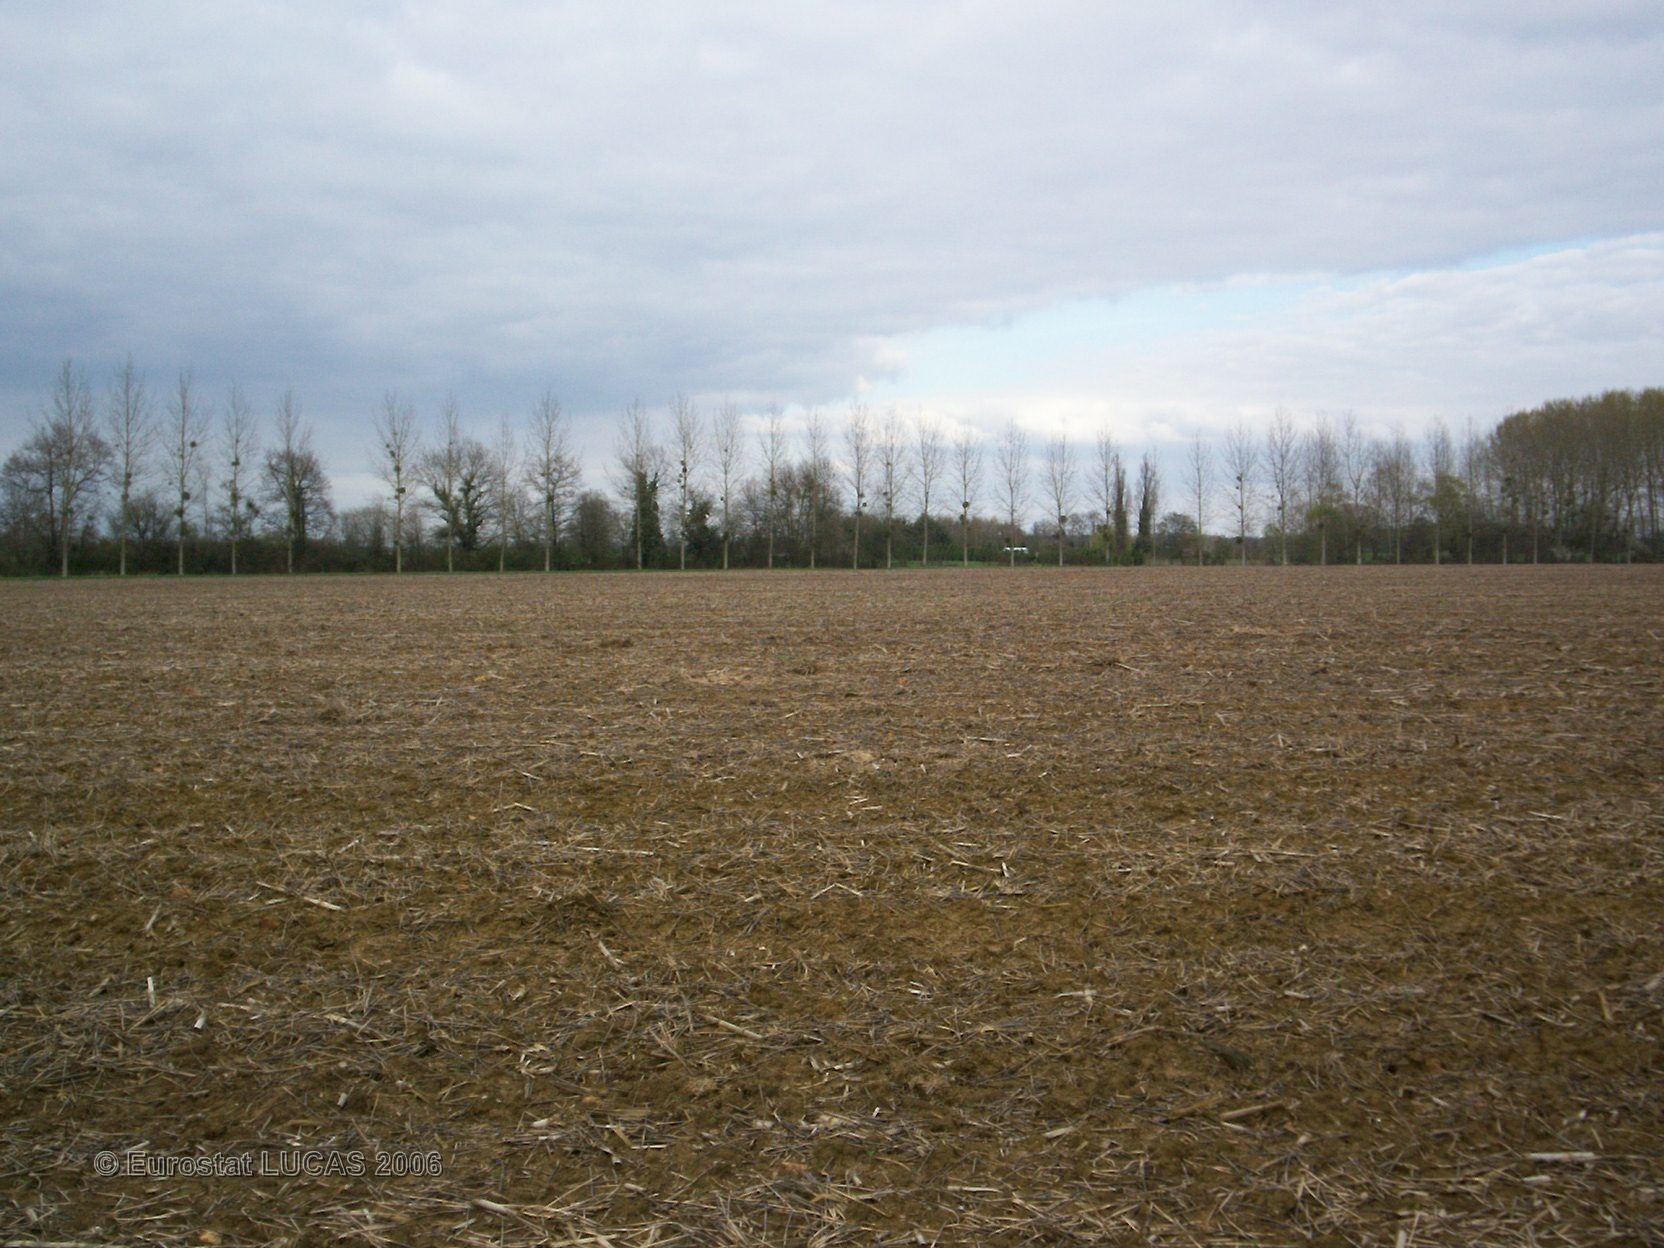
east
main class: Cropland
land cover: Maize
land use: Agriculture (excluding fallow land and kitchen gardens)
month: May
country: FR
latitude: 48.1984
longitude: 0.3550
